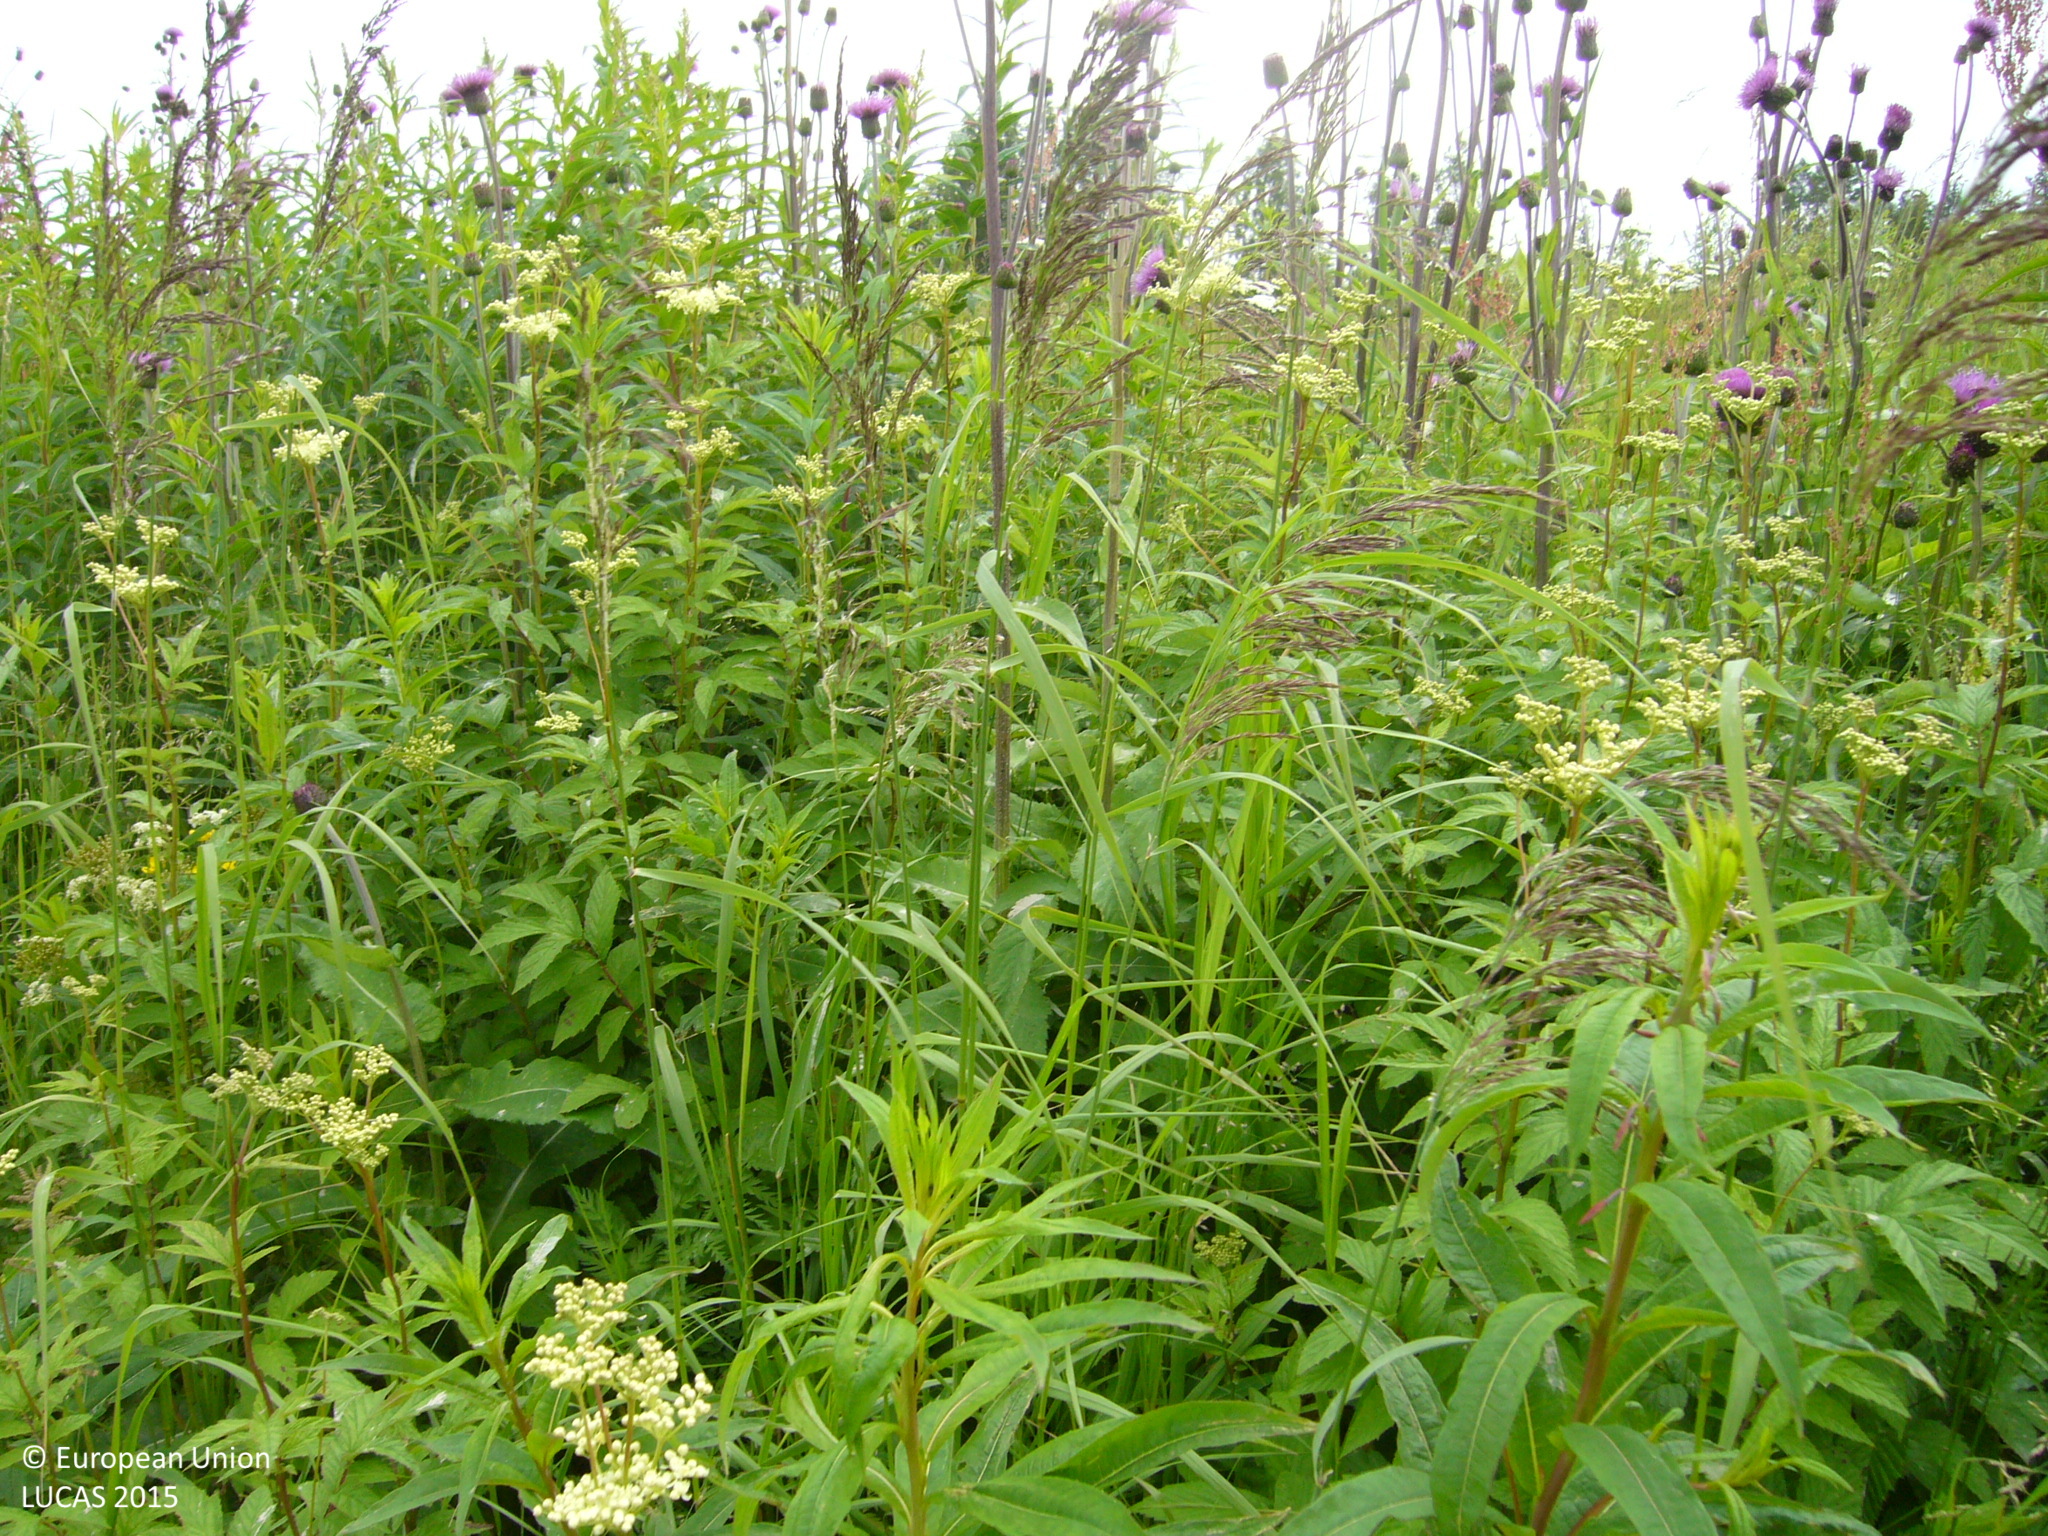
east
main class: Cropland
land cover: Barley
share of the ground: > 75 %
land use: Agriculture (excluding fallow land and kitchen gardens)
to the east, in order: Barley; Ditches and canals; Abandoned hedges; Grassland without tree/shrub cover; Paved roads, cycling and walking lanes; Grass margins; Inland fresh running water; Abandoned hedges; Temporary grasslands
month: July
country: FI
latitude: 63.6867
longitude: 25.1140
